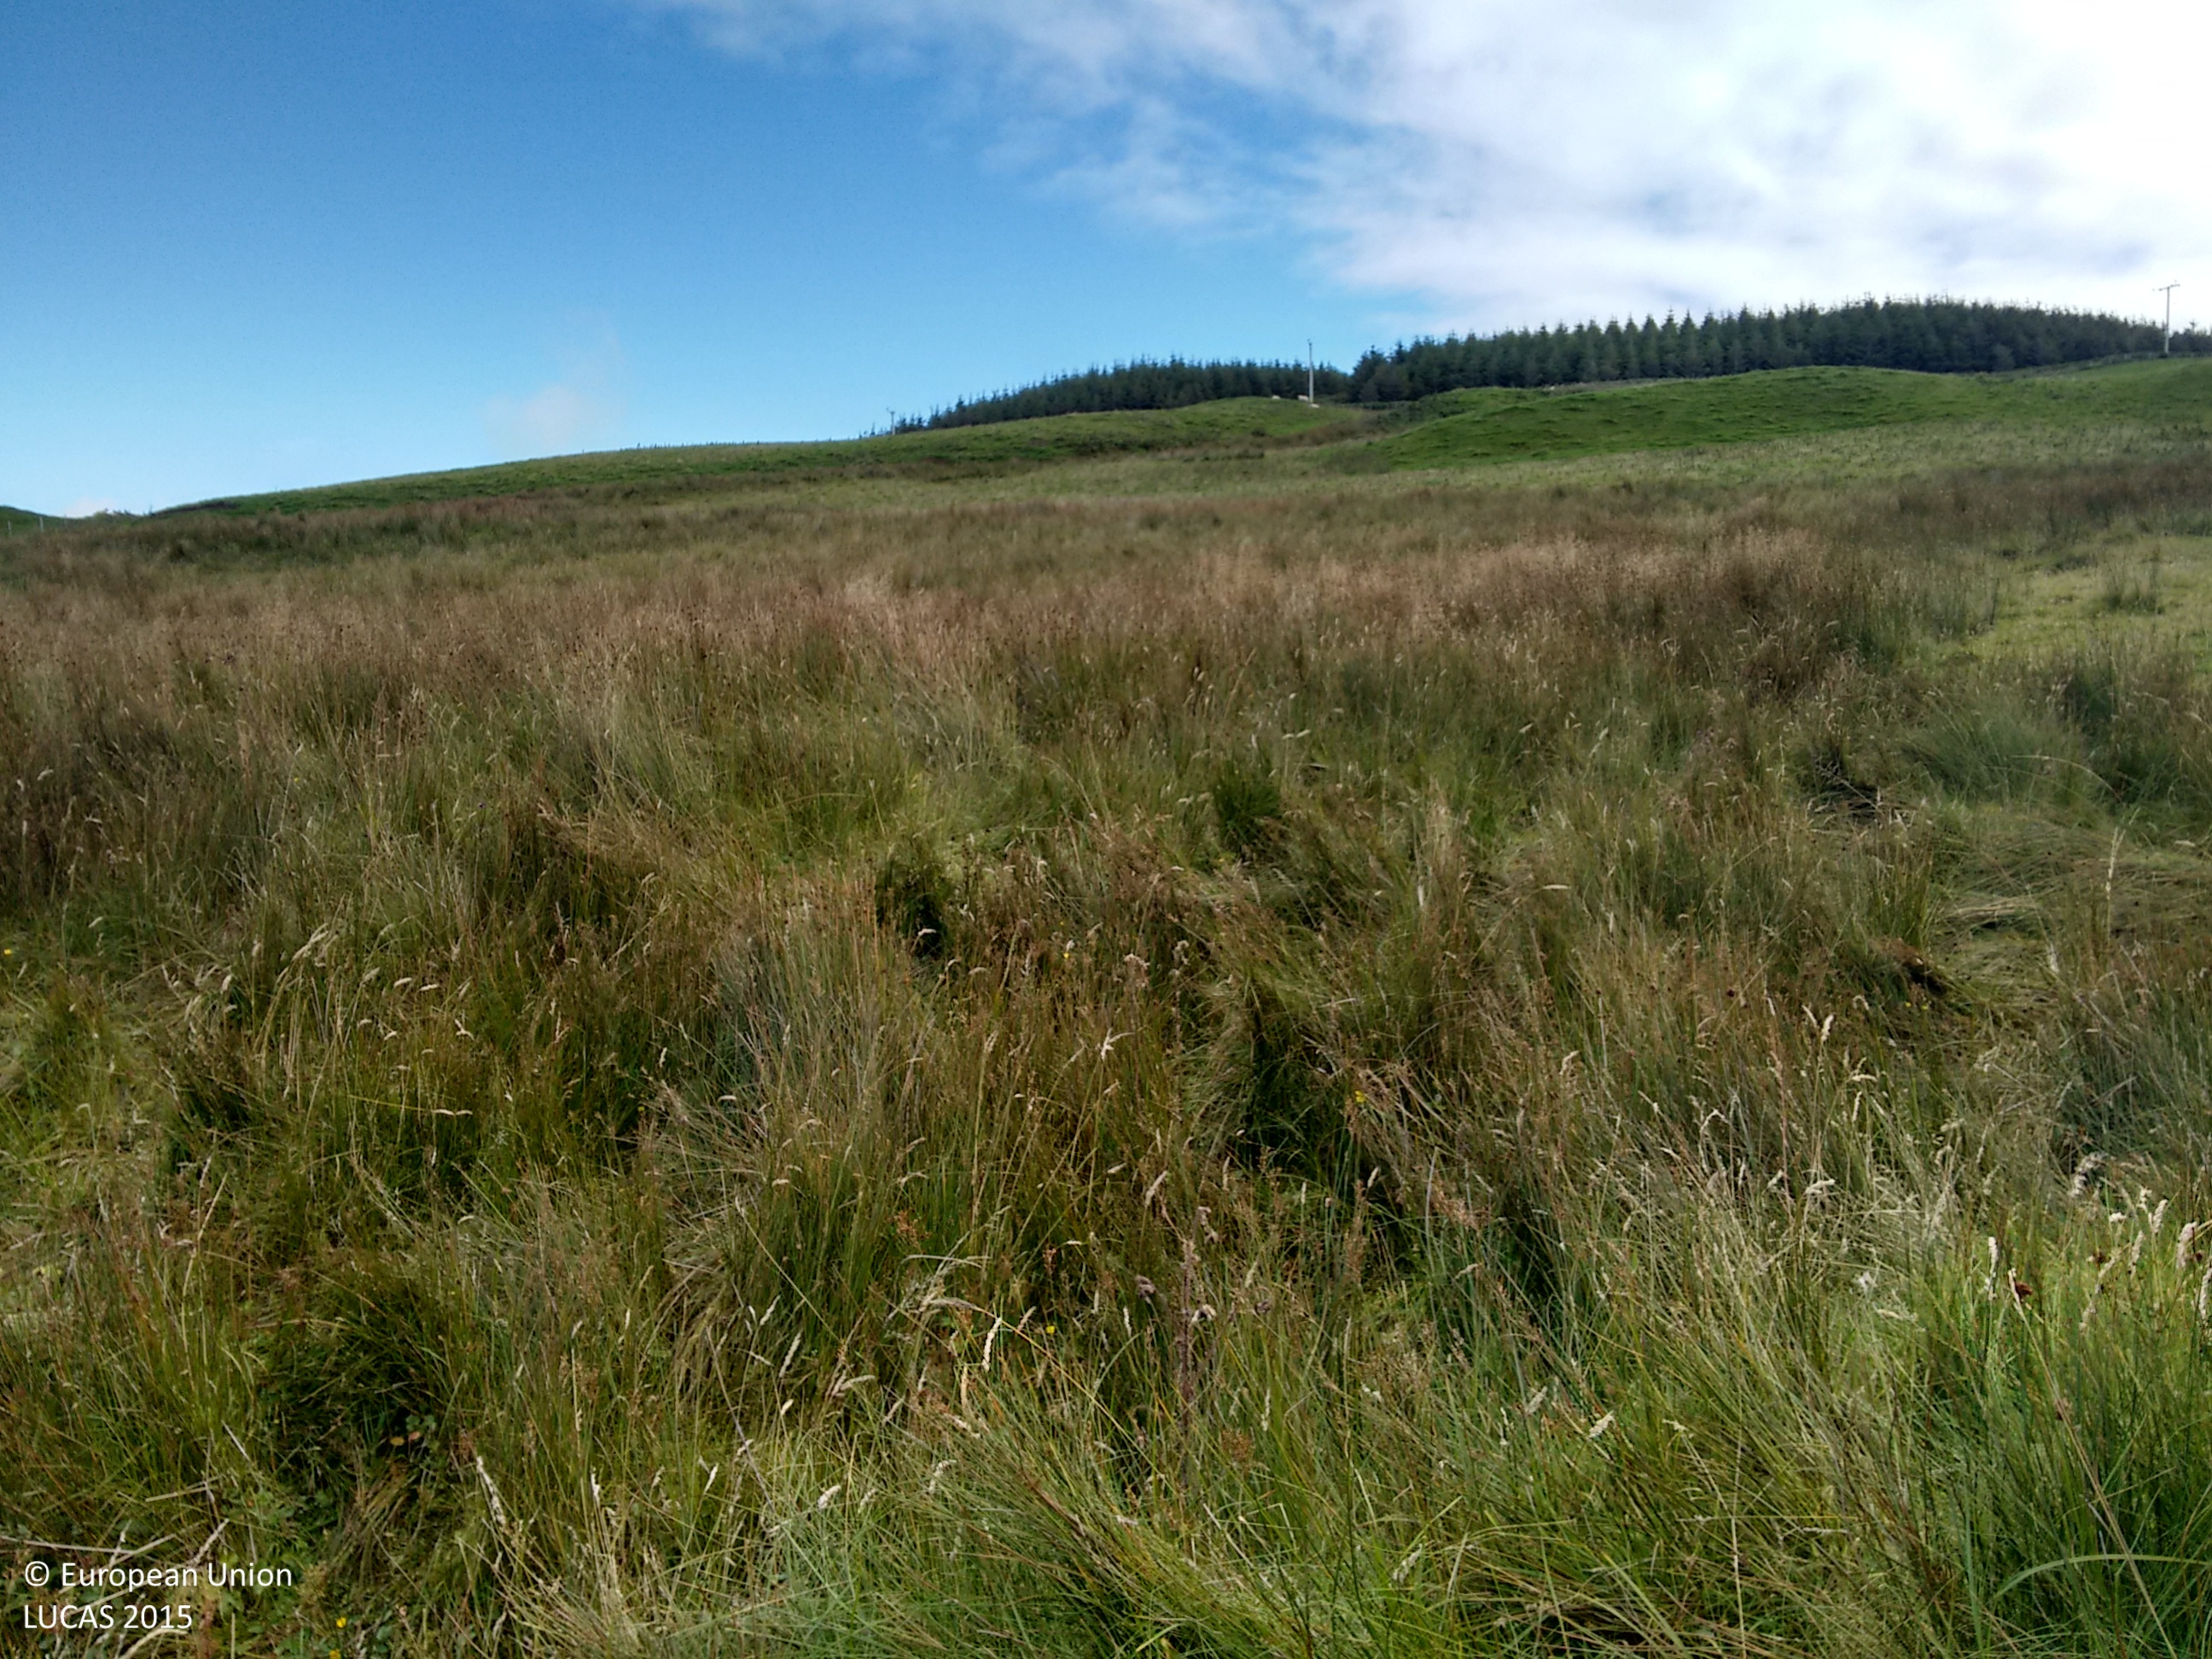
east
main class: Grassland
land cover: Grassland without tree/shrub cover
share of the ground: > 75 %
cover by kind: herbaceous plants 100 %
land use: Agriculture (excluding fallow land and kitchen gardens)
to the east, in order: Grassland without tree/shrub cover; Rivers and streams; Grassland without tree/shrub cover; Fences; Electric lines; Grassland without tree/shrub cover; Spruce dominated coniferous woodland
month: September
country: GB
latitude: 55.4077
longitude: -5.7514
